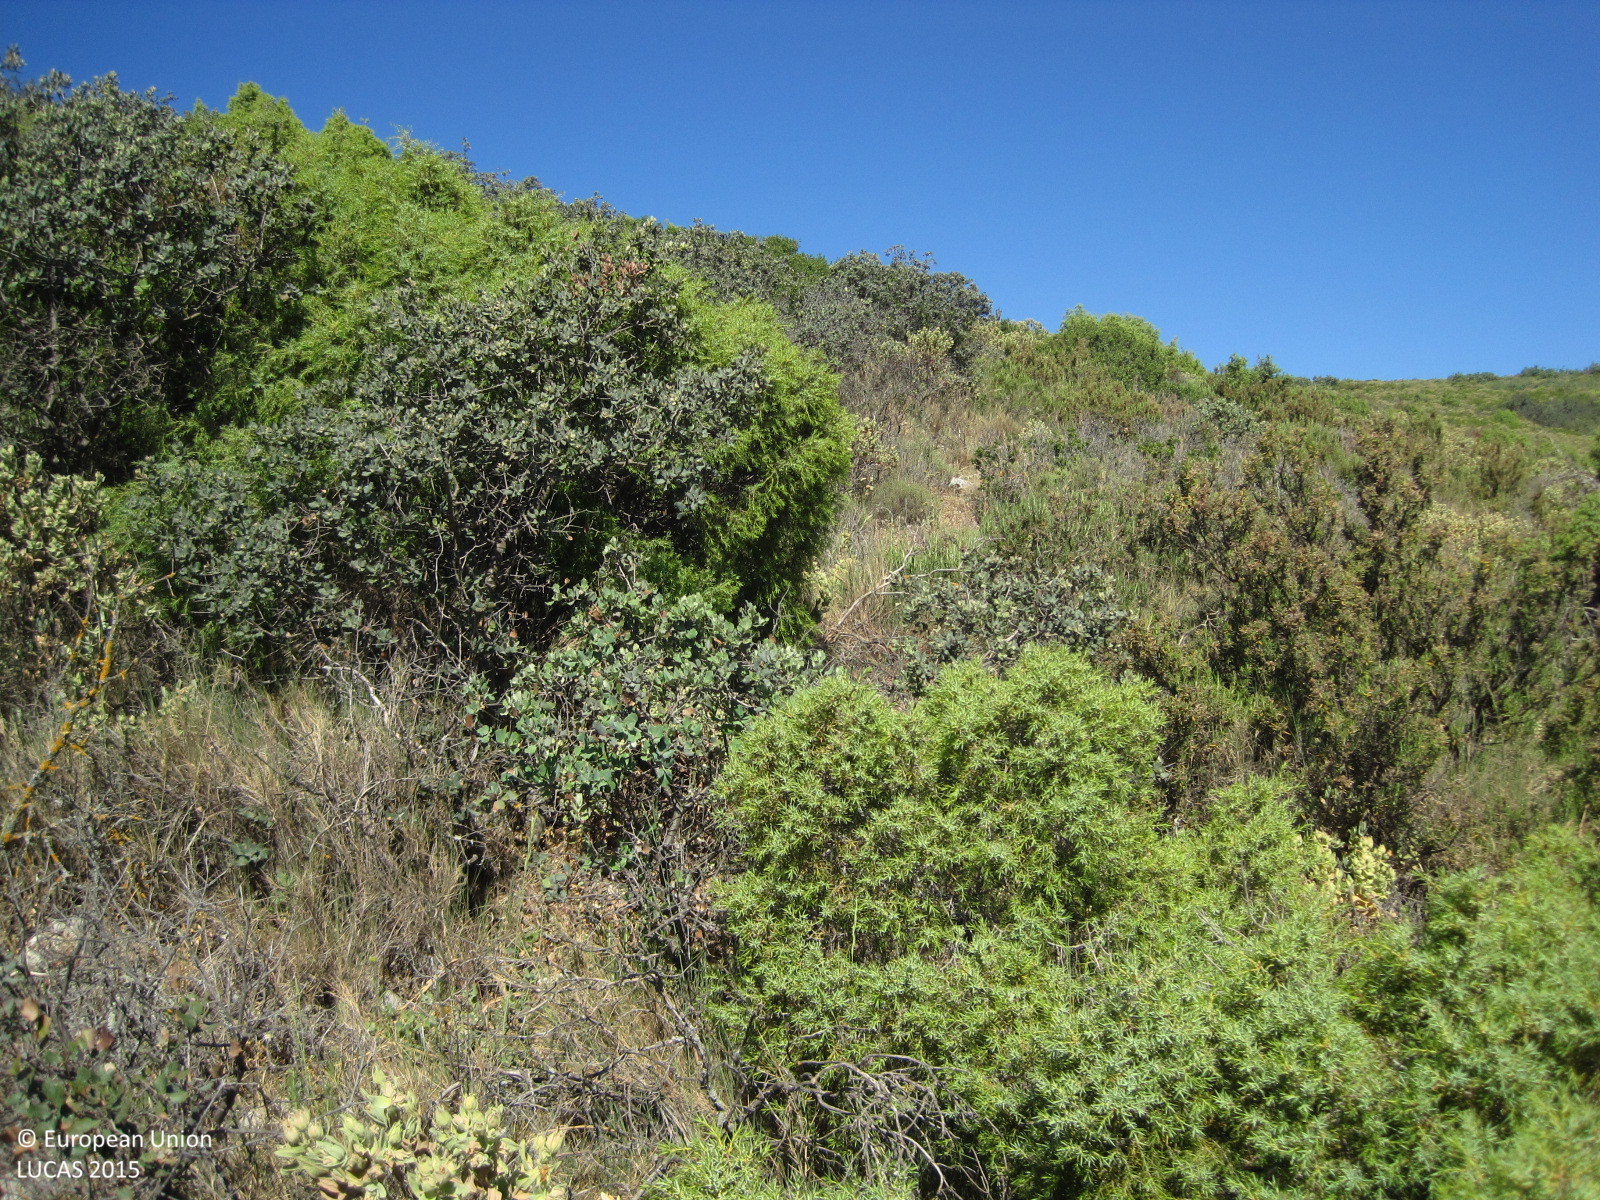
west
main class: Woodland
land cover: Broadleaved woodland
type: acidophilous oak and oak-birch forest
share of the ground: 10 - 25 %
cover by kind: shrubs 80 %, broadleaved forest trees 10 %, herbaceous plants 5 %, consolidated bare surface 5 %
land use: Semi-natural and natural areas not in use
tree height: < 5 m
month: May
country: ES
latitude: 39.4663
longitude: -0.8208
